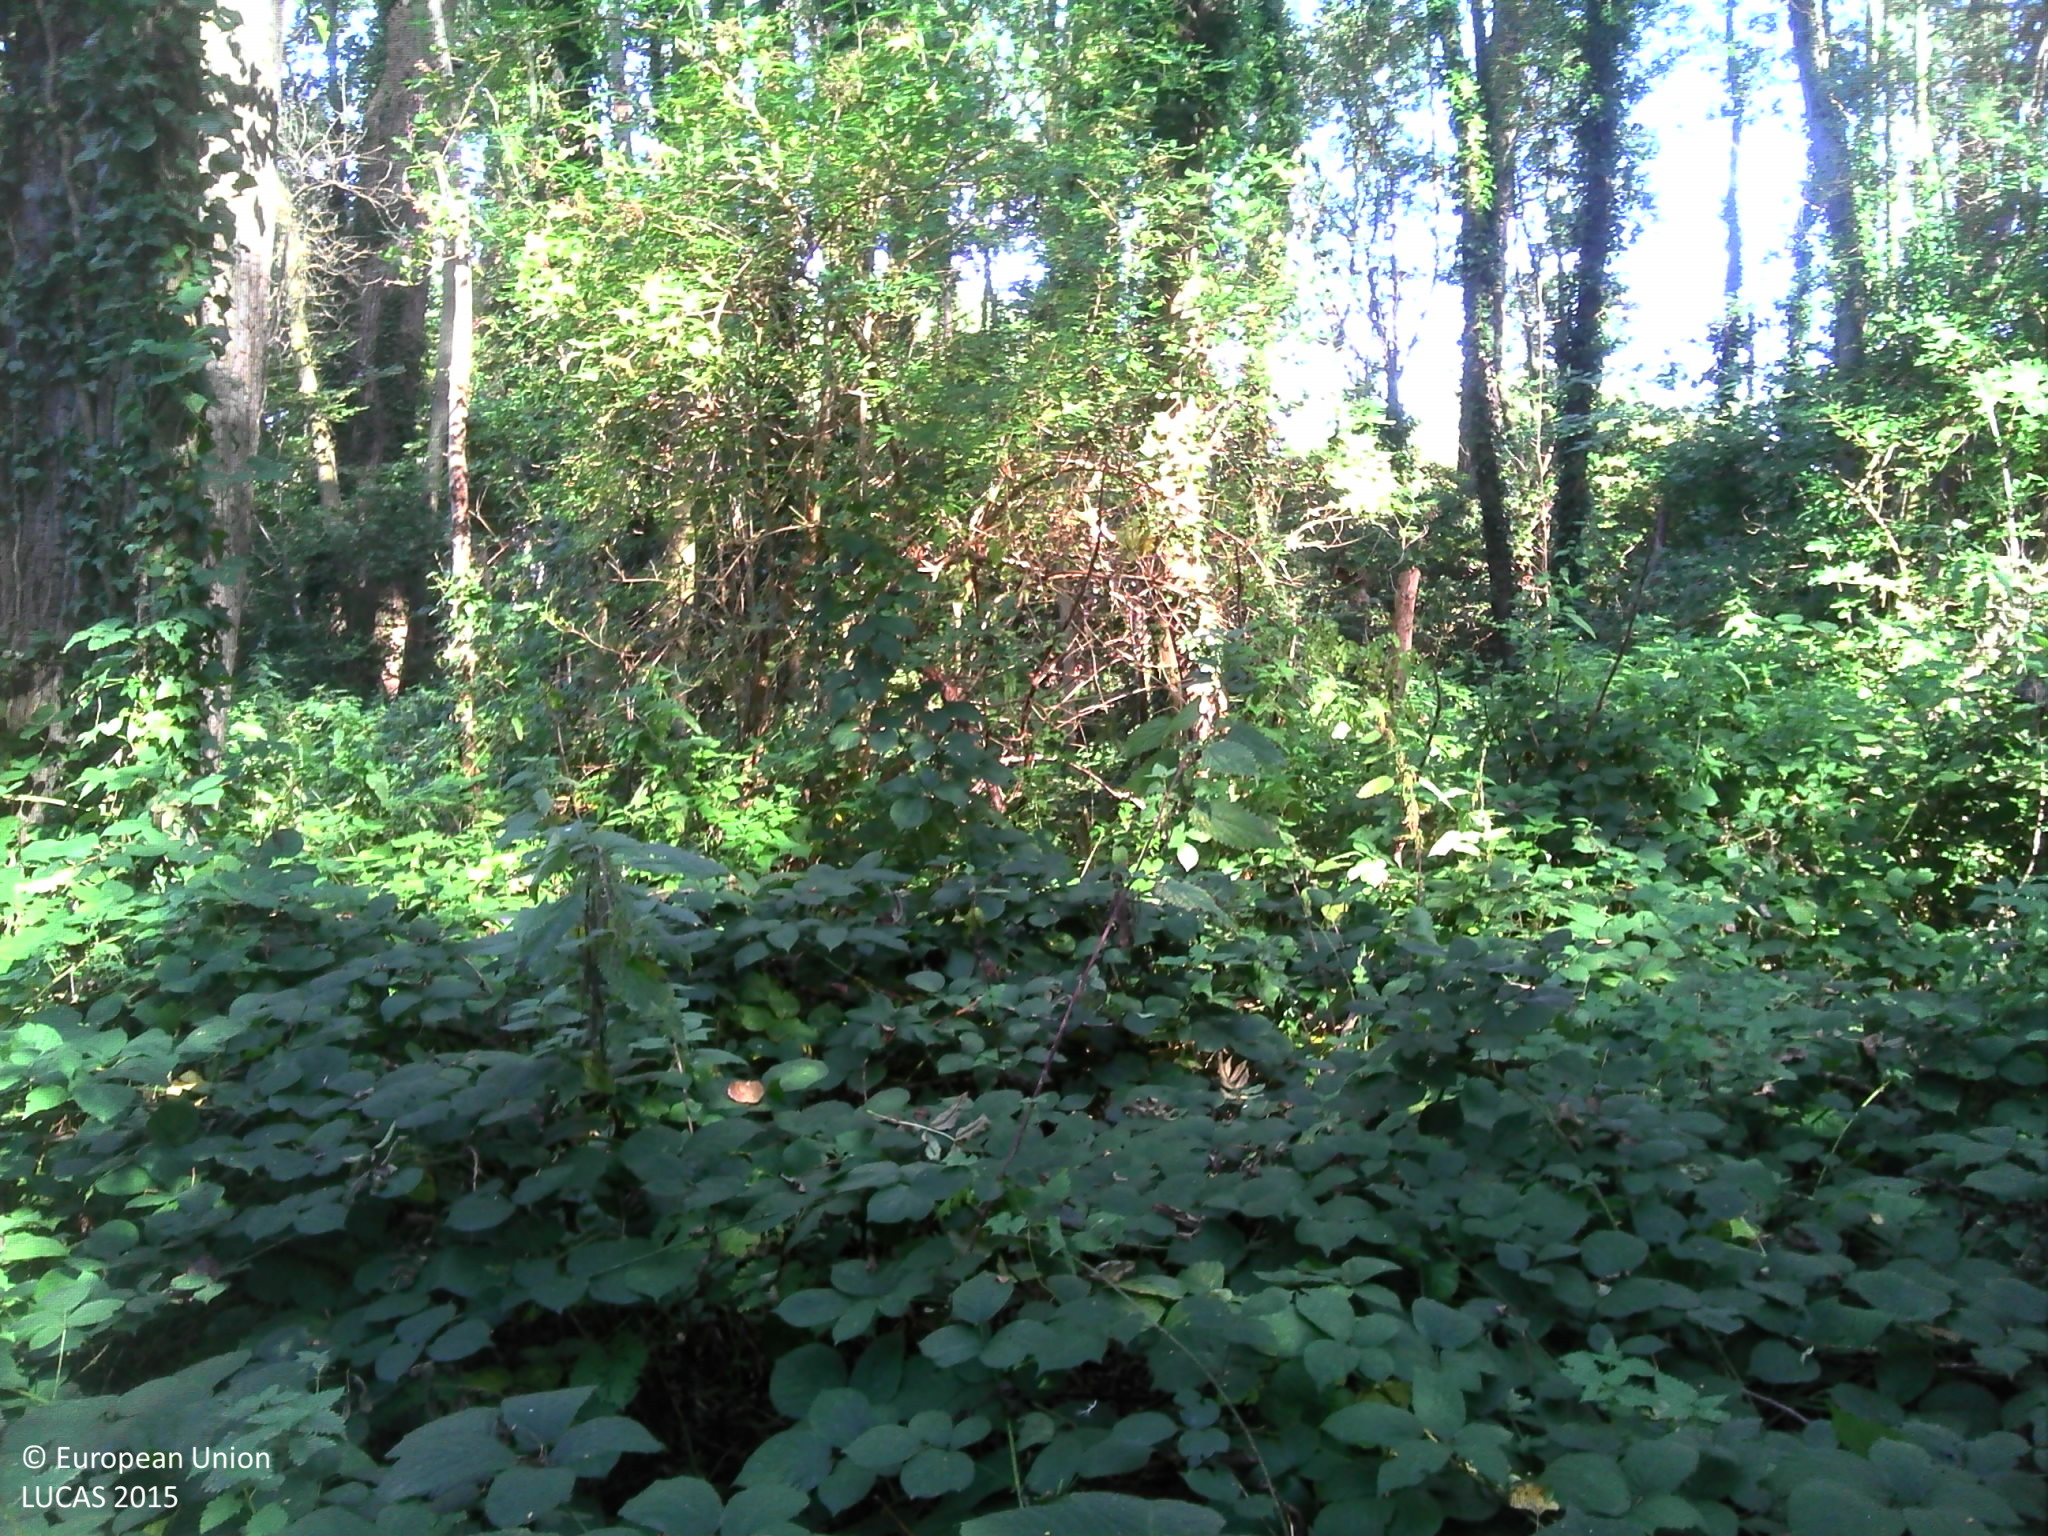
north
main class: Woodland
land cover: Broadleaved woodland
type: non-riverine alder, birch or aspen forest
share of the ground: > 75 %
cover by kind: broadleaved forest trees 95 %, herbaceous plants 5 %
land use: Forestry
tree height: > 5 m
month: September
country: BE
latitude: 51.2162
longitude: 4.7423
